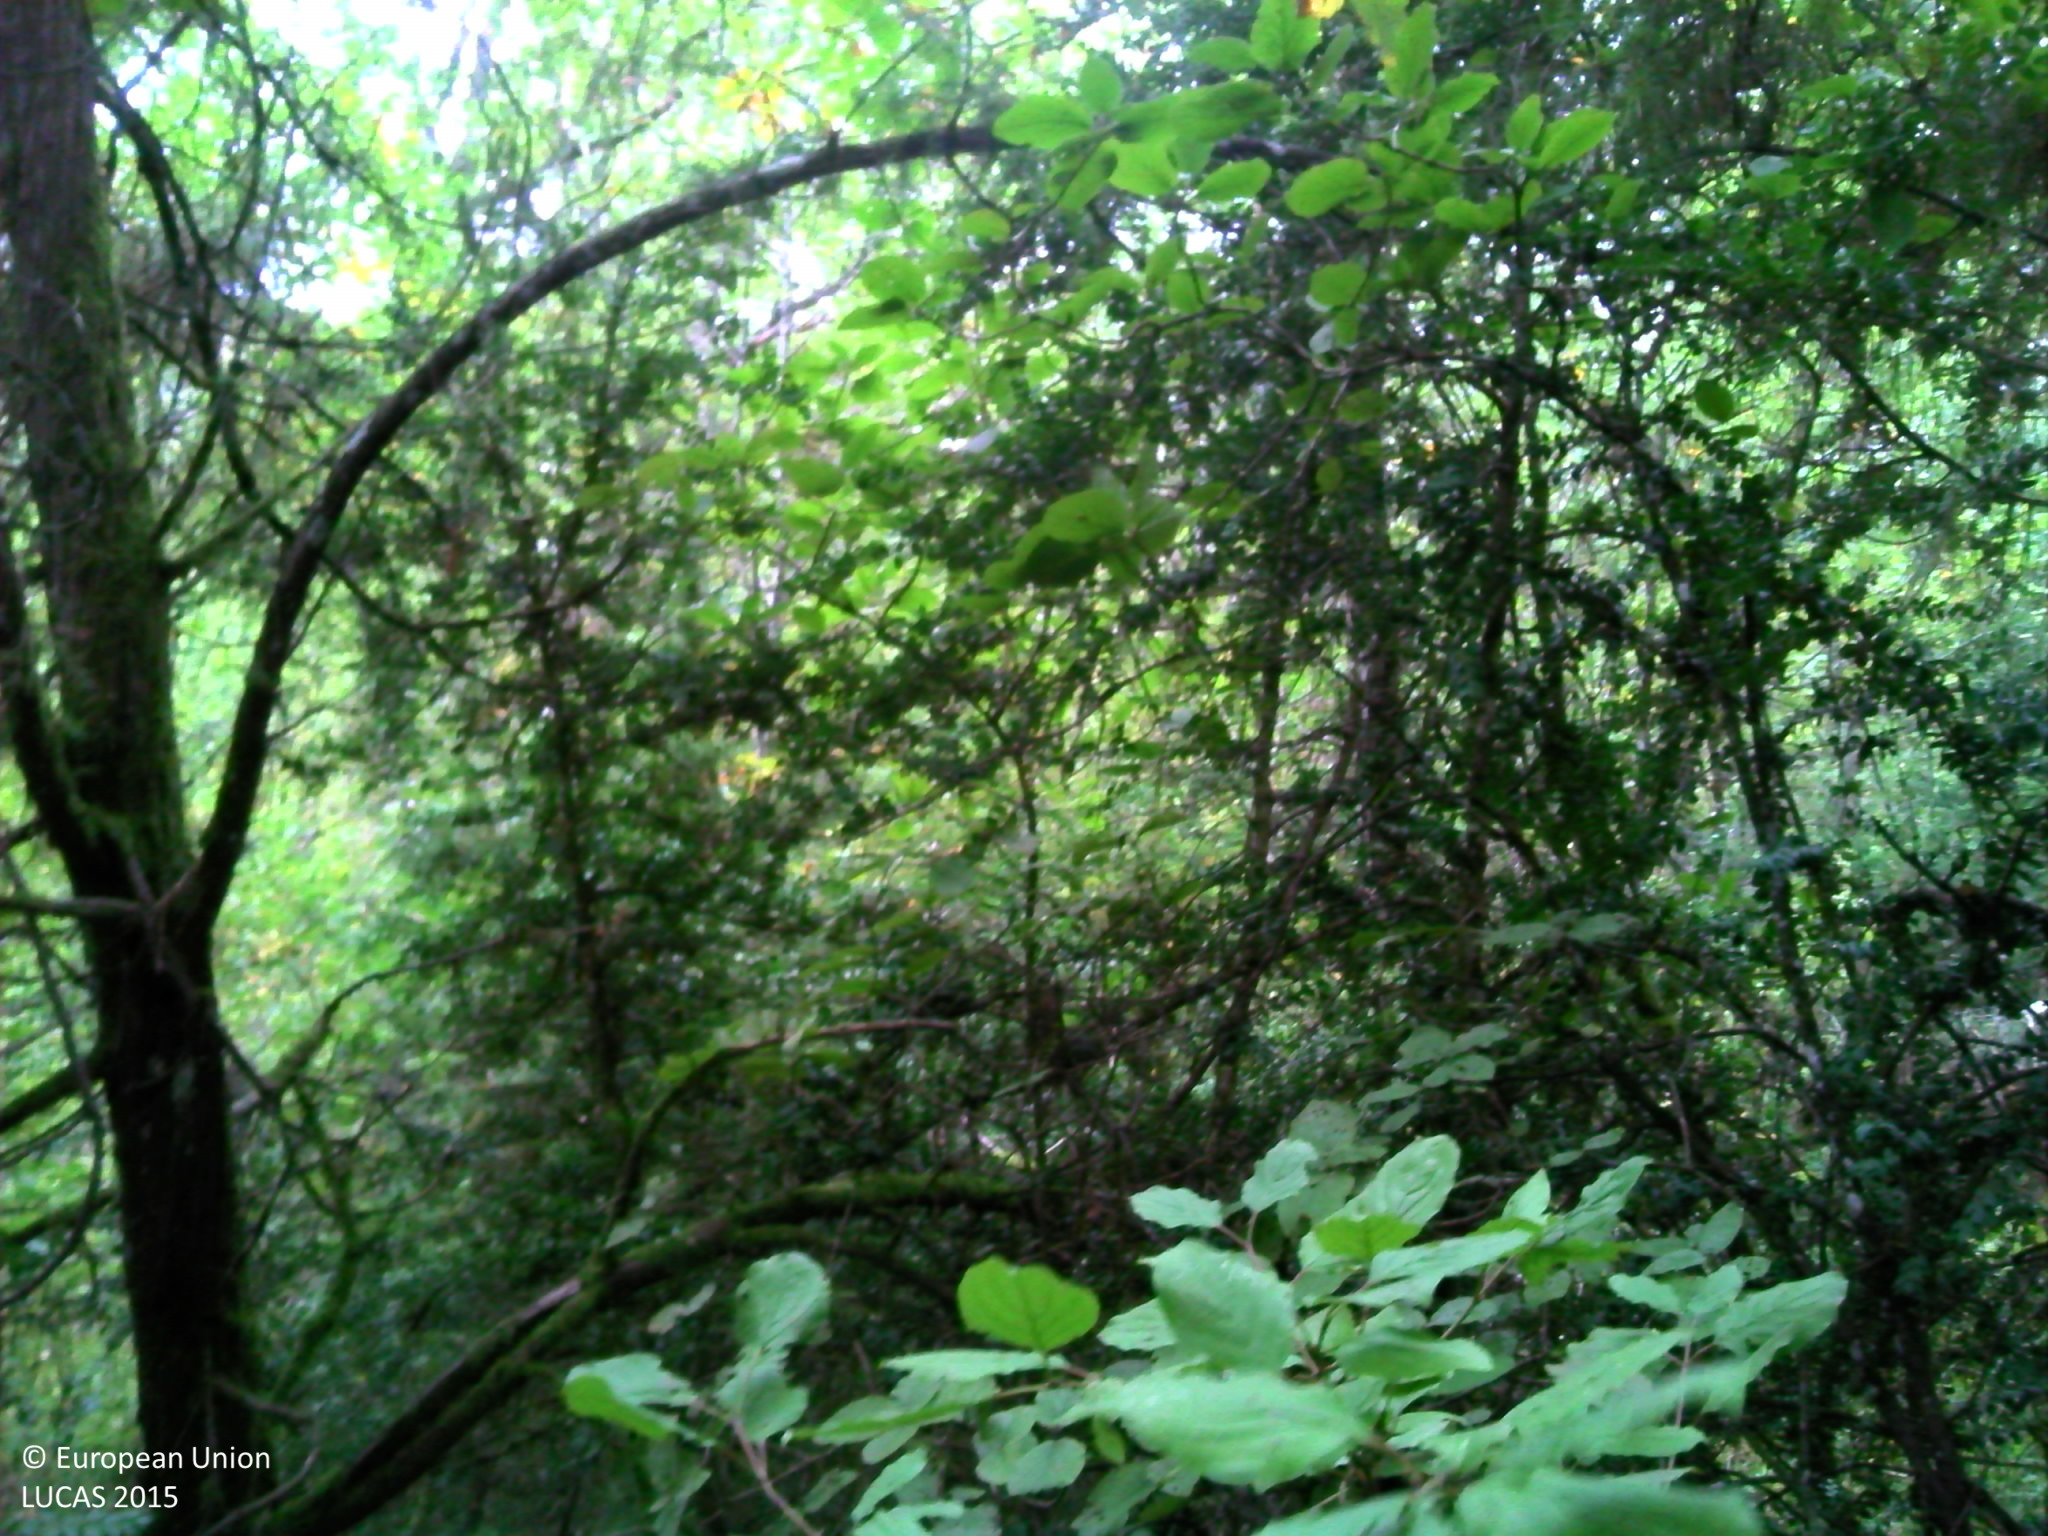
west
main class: Woodland
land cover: Pine dominated mixed woodland
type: hemiboreal forest and nemoral coniferous forest and mixed broadleaved-coniferous forest
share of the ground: > 75 %
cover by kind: coniferous forest trees 70 %, broadleaved forest trees 25 %, shrubs 5 %
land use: Forestry
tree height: > 5 m
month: September
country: FR
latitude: 47.0151
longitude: 4.7255
